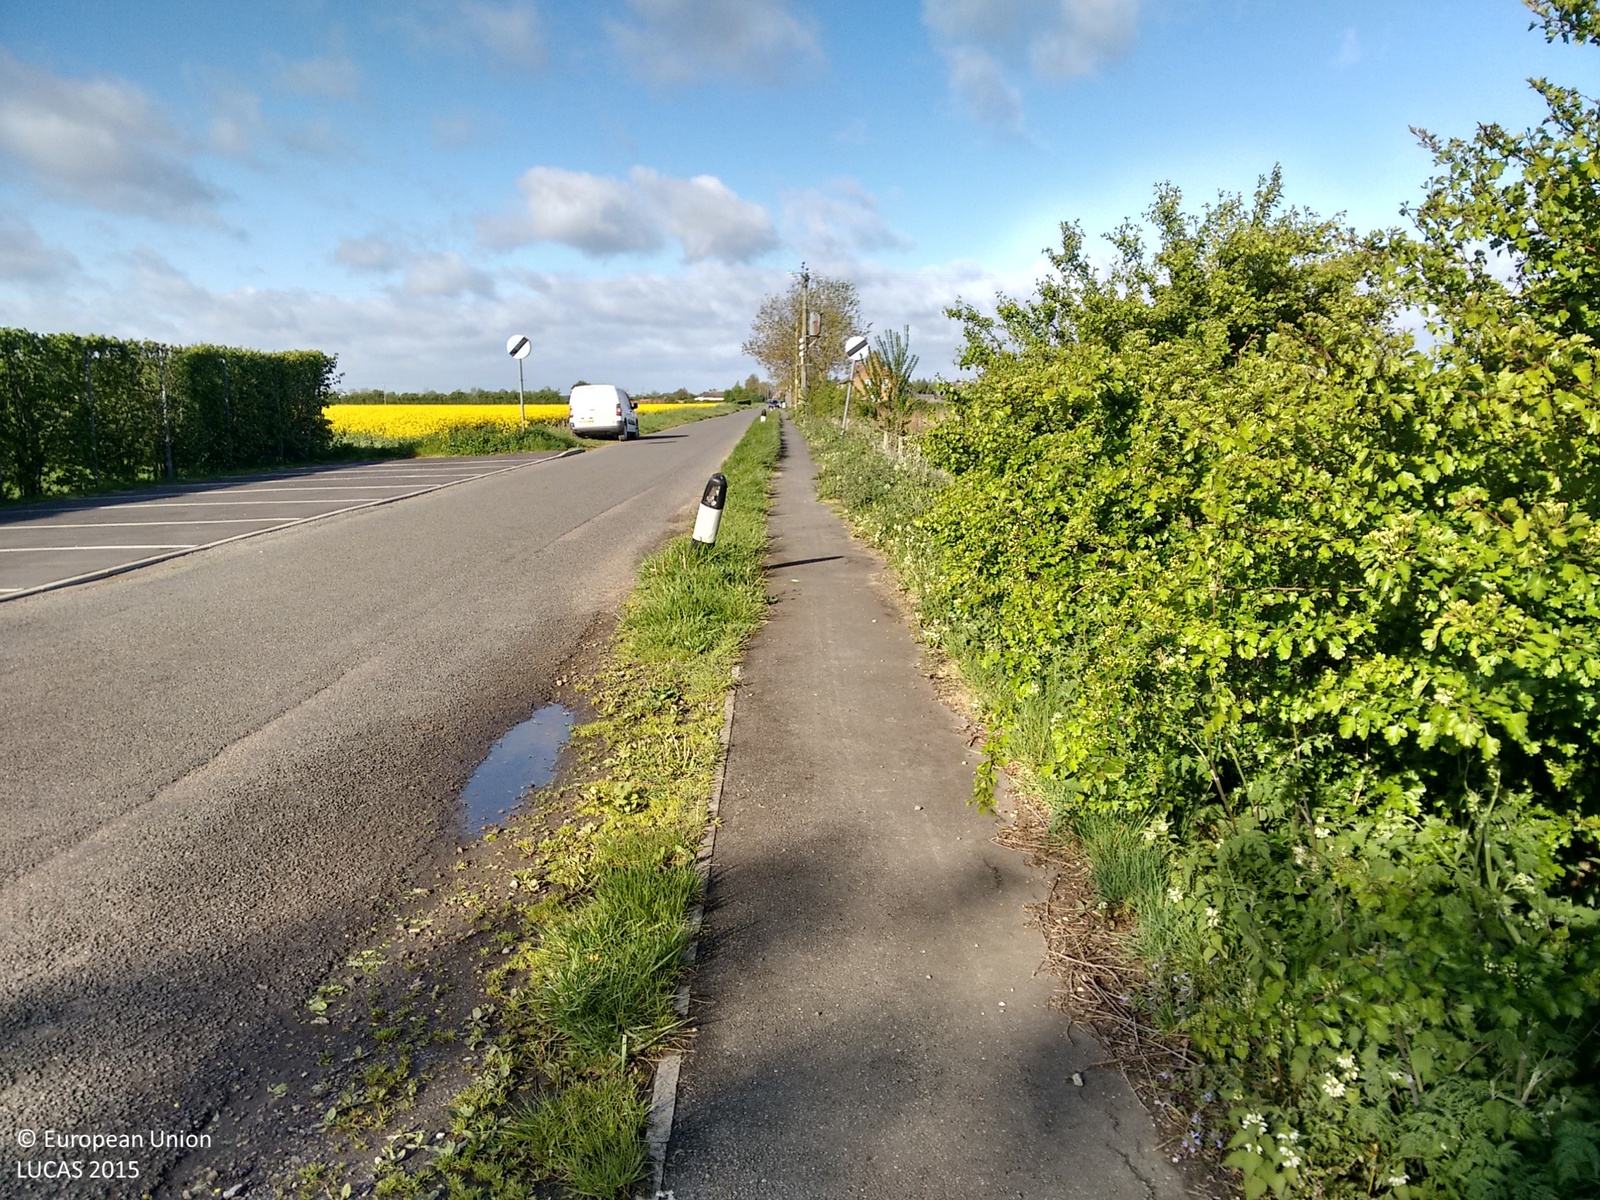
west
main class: Grassland
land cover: Grassland without tree/shrub cover
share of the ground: > 75 %
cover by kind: herbaceous plants 100 %
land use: Agriculture (excluding fallow land and kitchen gardens)
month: May
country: GB
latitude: 53.0661
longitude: -0.1367
